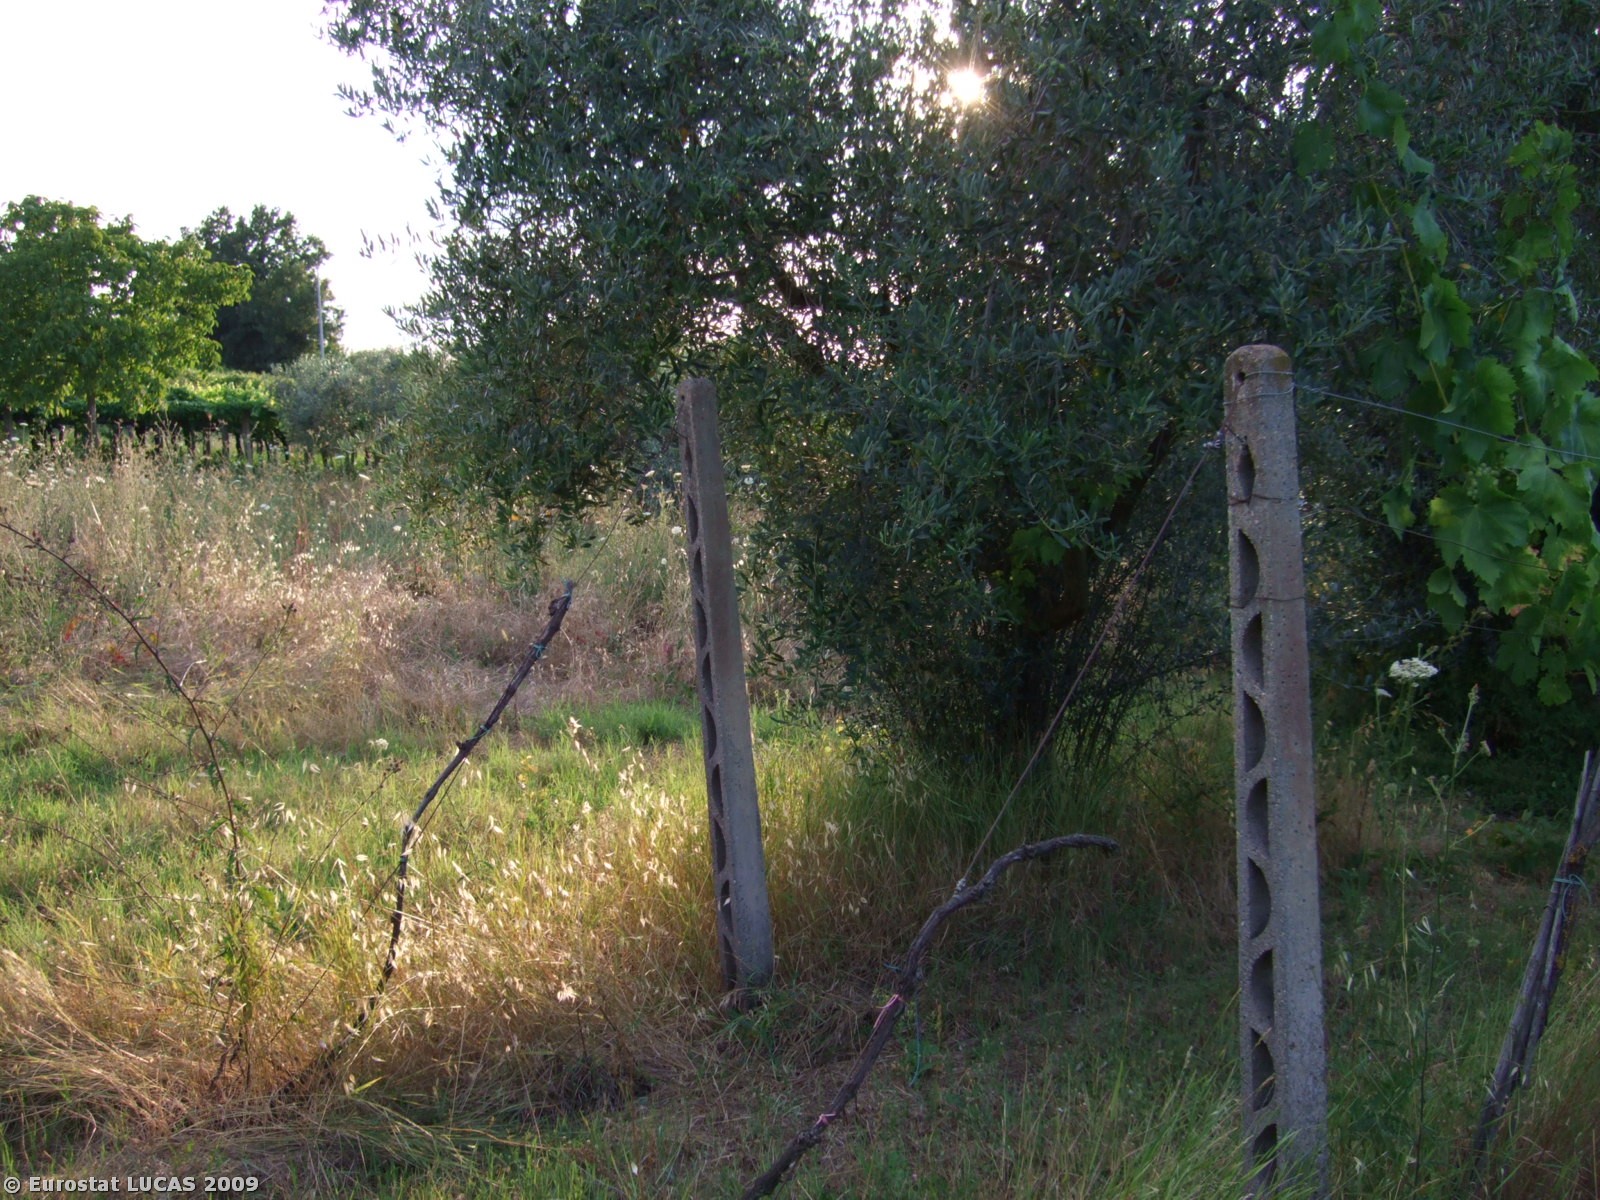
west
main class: Cropland
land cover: Vineyards
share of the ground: 50 - 75 %
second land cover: Grassland with sparse tree/shrub cover
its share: 50 - 75 %
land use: Kitchen garden
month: July
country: IT
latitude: 41.8395
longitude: 12.7475
